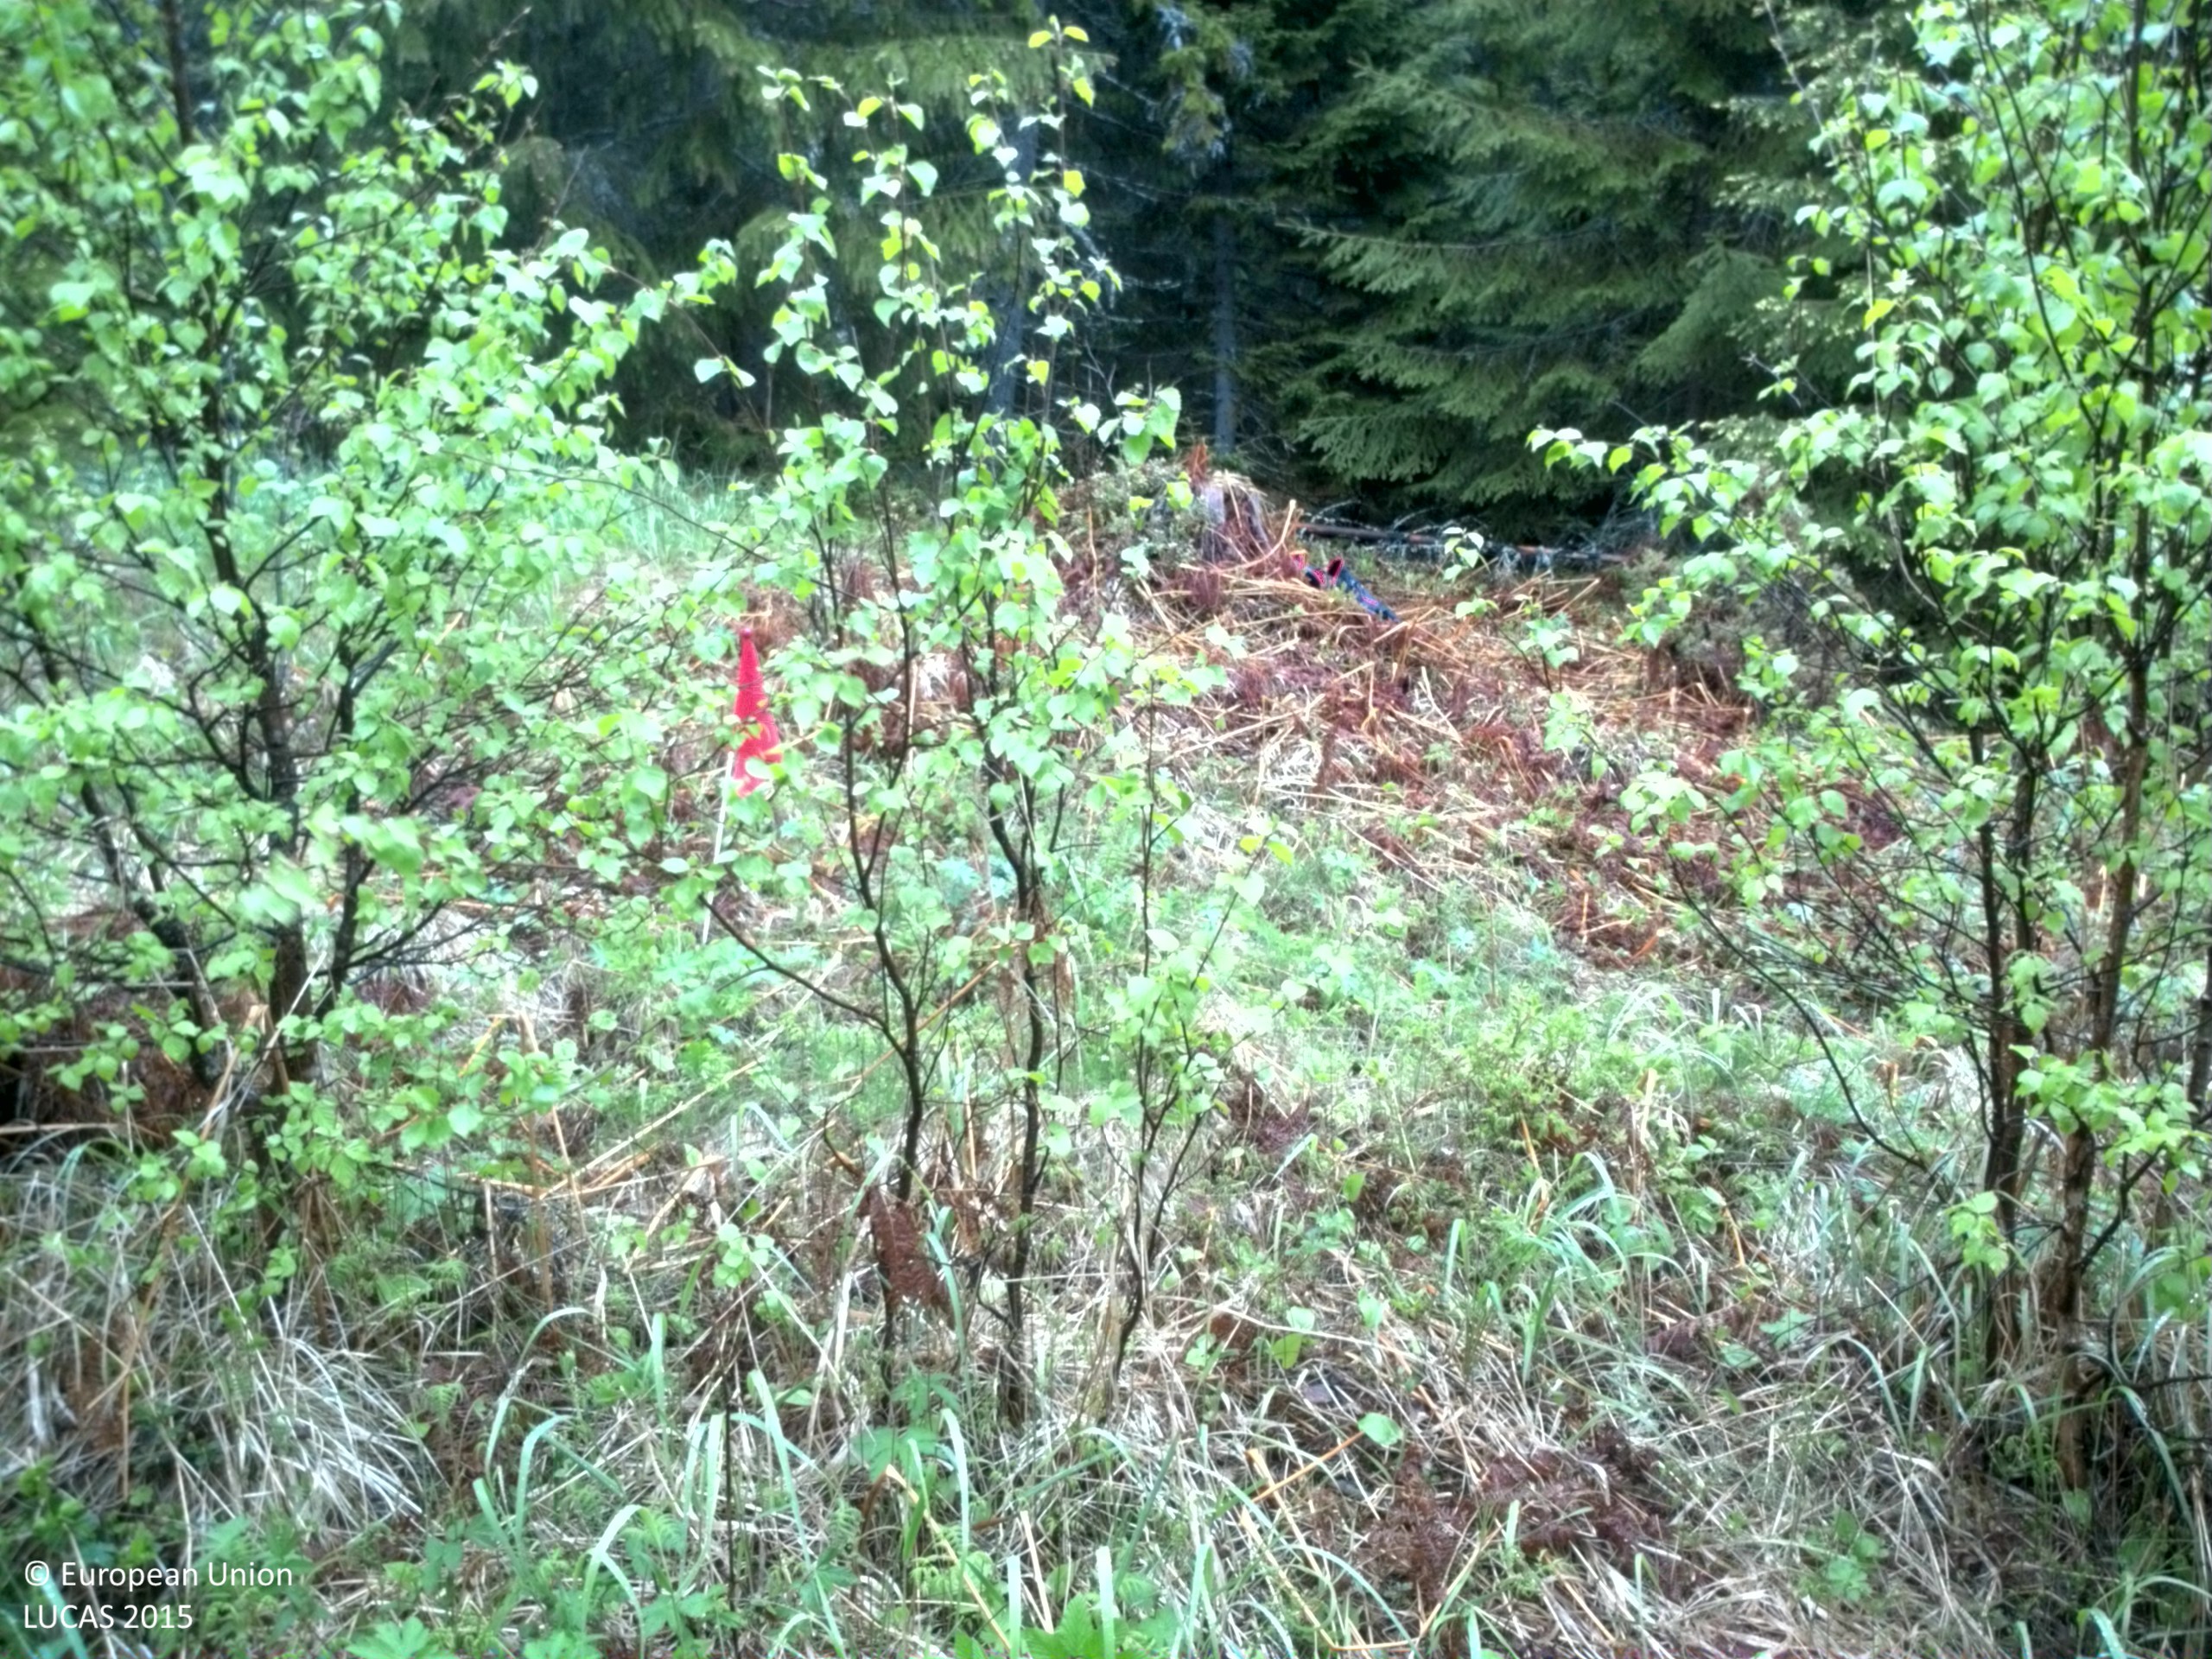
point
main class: Woodland
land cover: Spruce dominated mixed woodland
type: boreal forest
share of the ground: 50 - 75 %
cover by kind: coniferous forest trees 45 %, herbaceous plants 30 %, broadleaved forest trees 15 %, shrubs 10 %
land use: Forestry
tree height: < 5 m
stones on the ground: 25 - 50 %
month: May
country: SE
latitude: 63.0672
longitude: 17.7146
